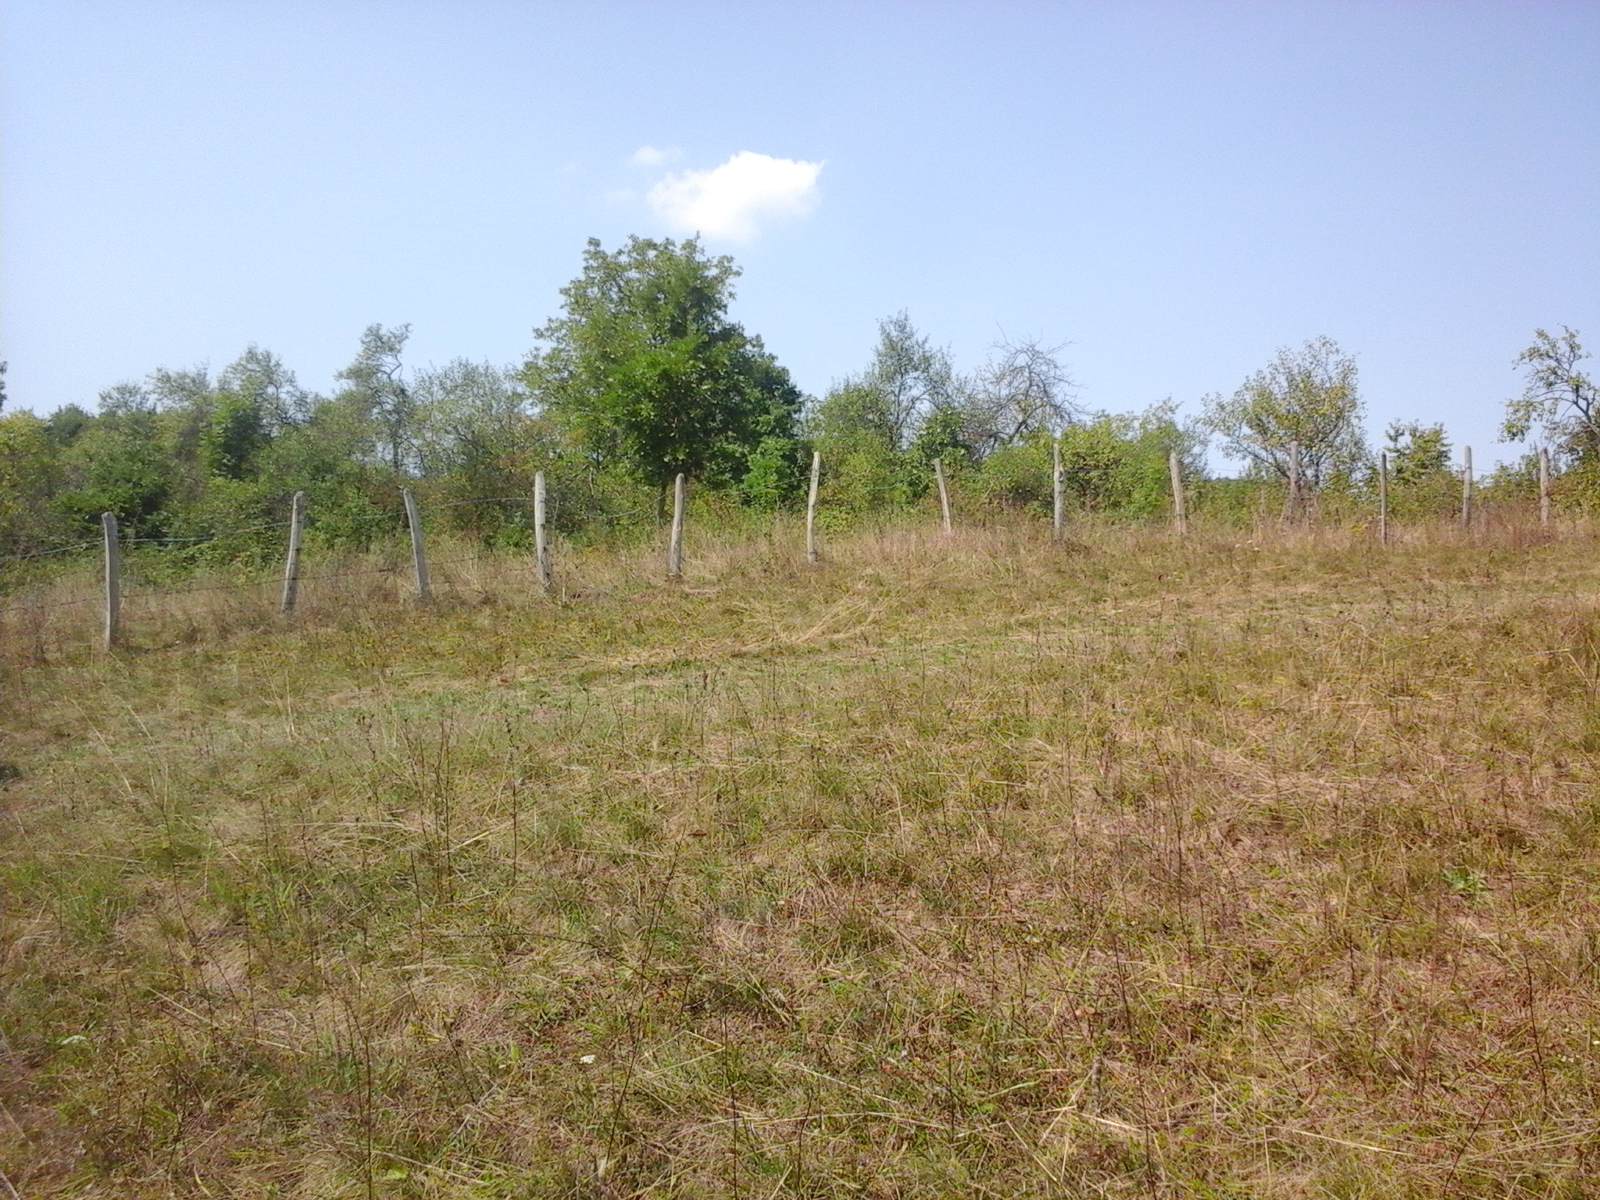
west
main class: Grassland
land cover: Grassland without tree/shrub cover
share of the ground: > 75 %
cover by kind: herbaceous plants 100 %
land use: Agriculture (excluding fallow land and kitchen gardens)
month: August
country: RO
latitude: 46.1844
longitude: 22.7630
